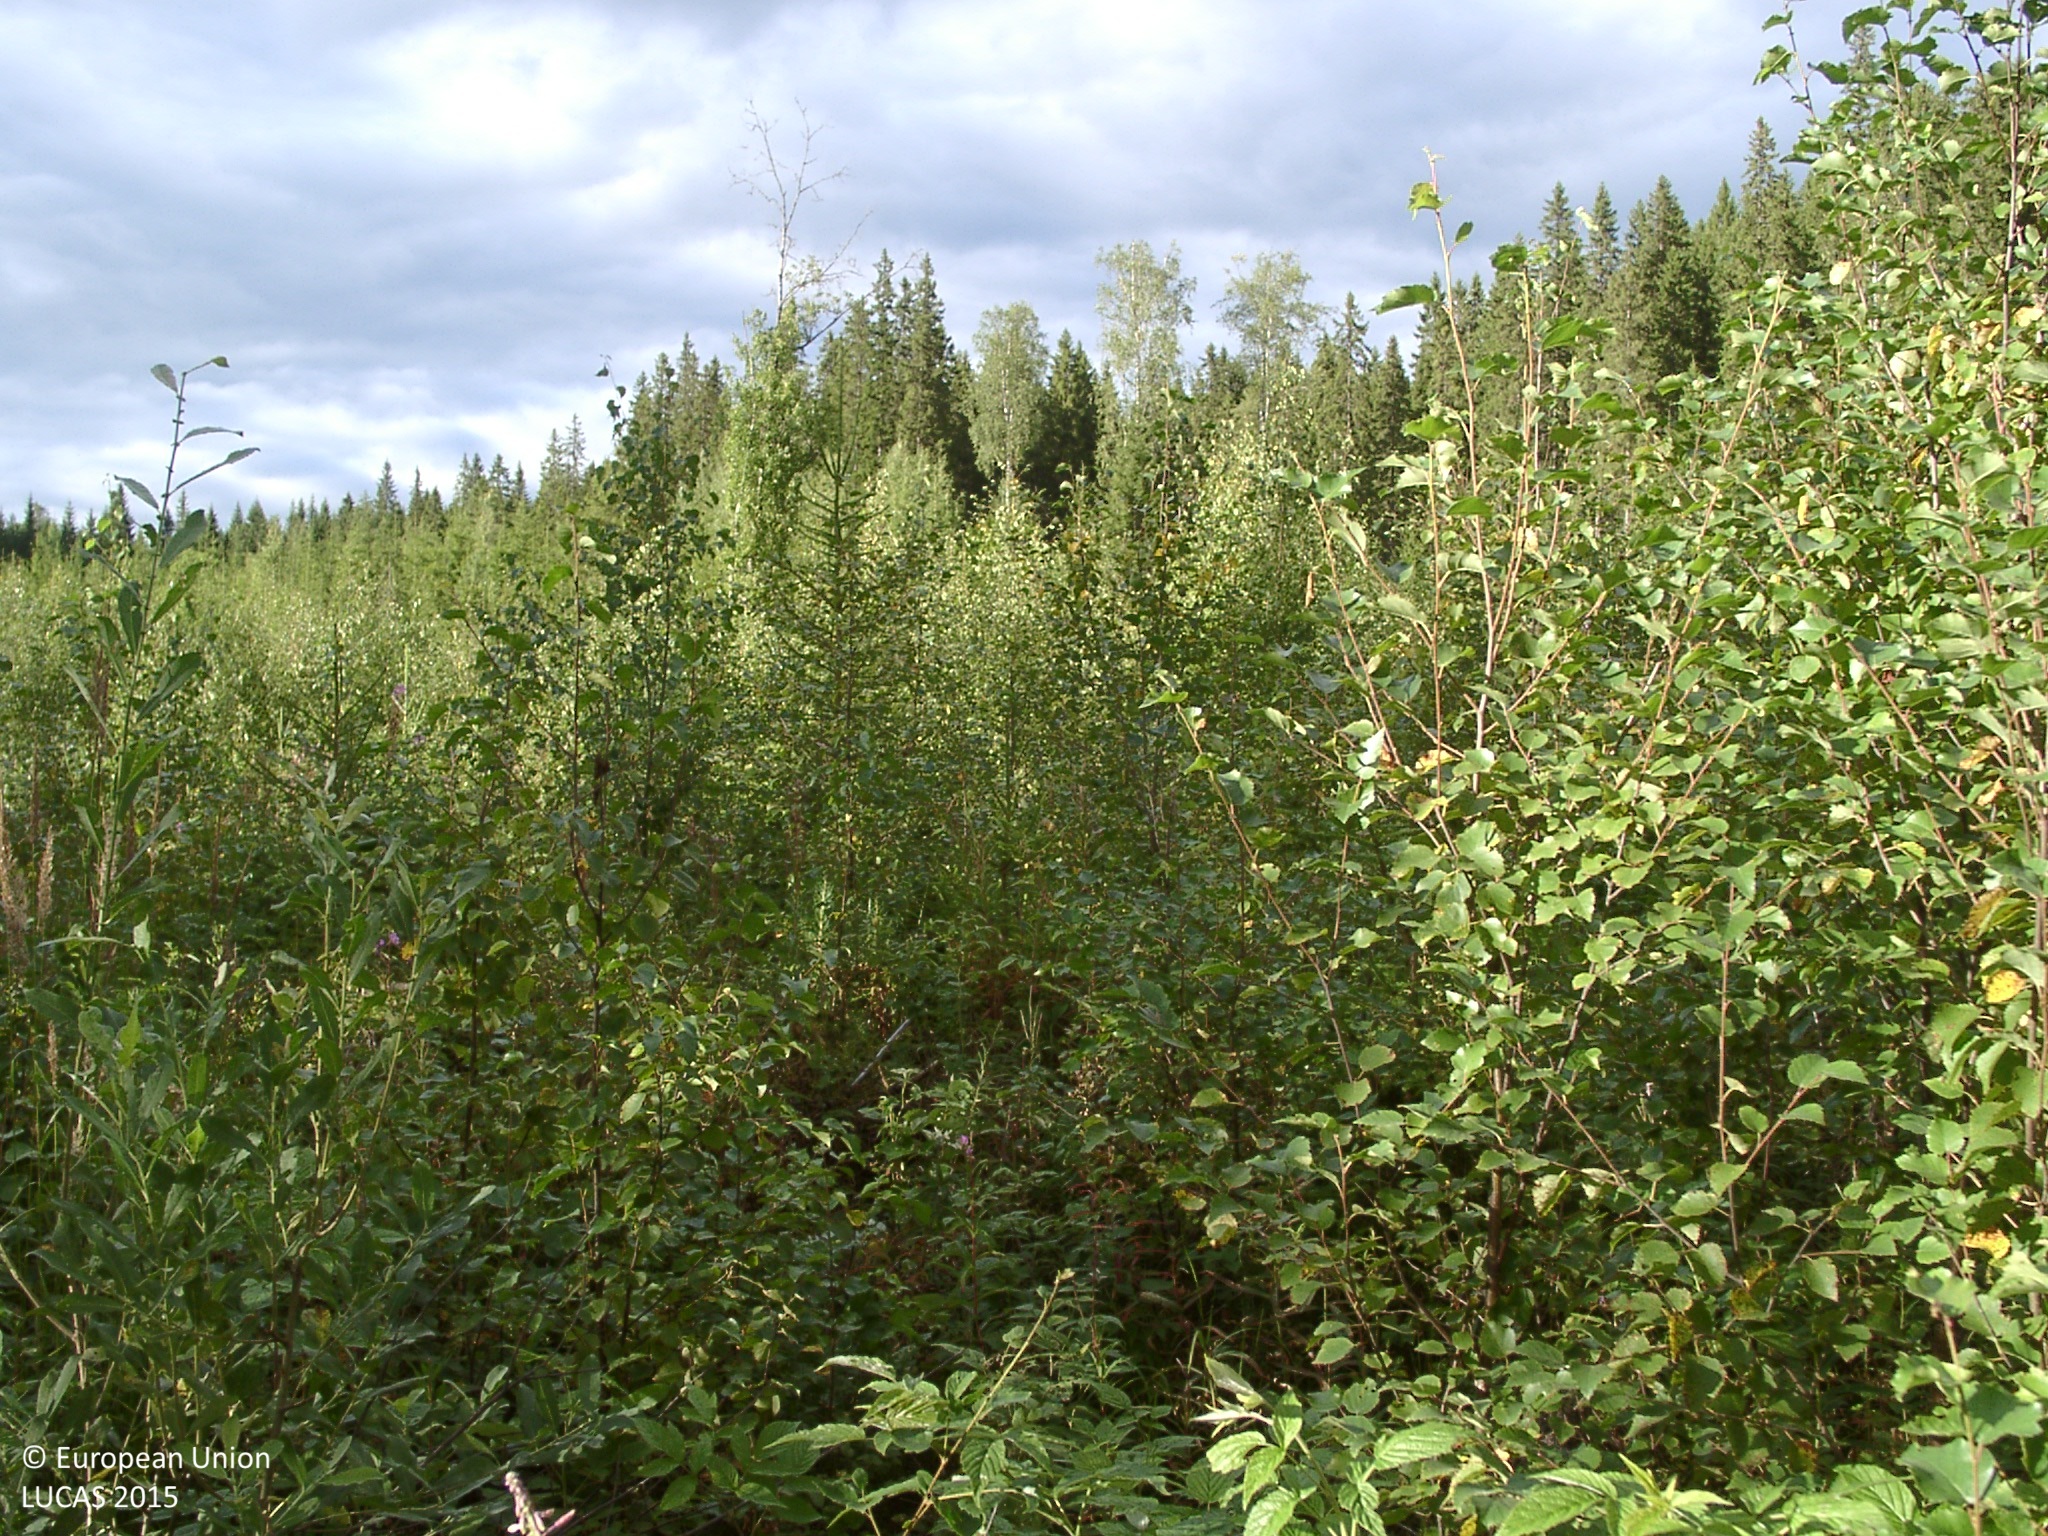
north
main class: Woodland
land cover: Broadleaved woodland
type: boreal forest
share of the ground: 25 - 50 %
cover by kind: shrubs 40 %, herbaceous plants 30 %, broadleaved forest trees 25 %, coniferous forest trees 5 %
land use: Forestry
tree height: < 5 m
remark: Nursery
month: August
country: FI
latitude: 62.3681
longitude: 25.5570
